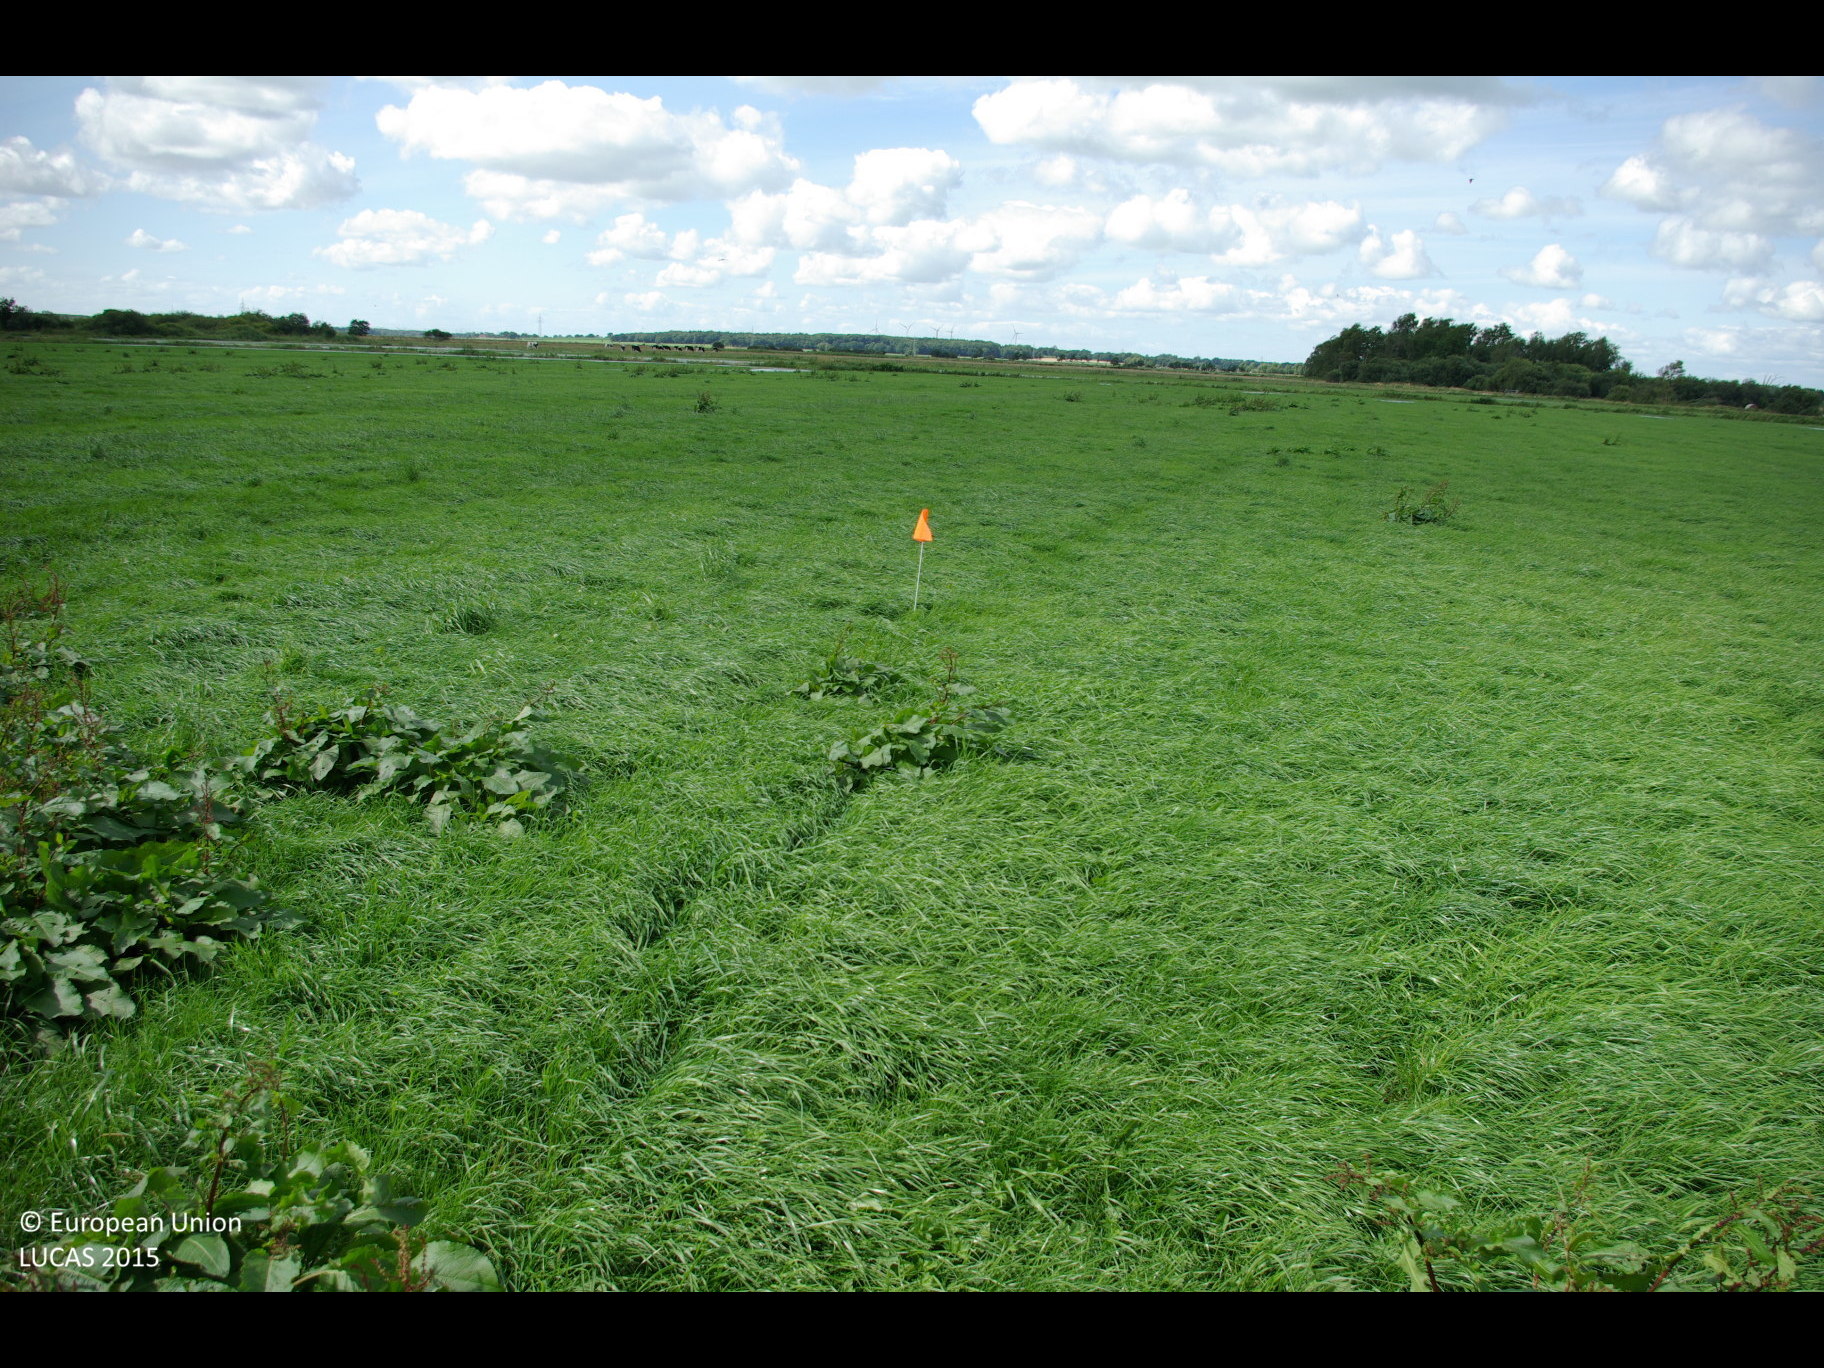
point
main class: Grassland
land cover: Grassland without tree/shrub cover
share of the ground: > 75 %
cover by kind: herbaceous plants 100 %
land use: Agriculture (excluding fallow land and kitchen gardens)
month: July
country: DE
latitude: 54.2080
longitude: 9.1879
